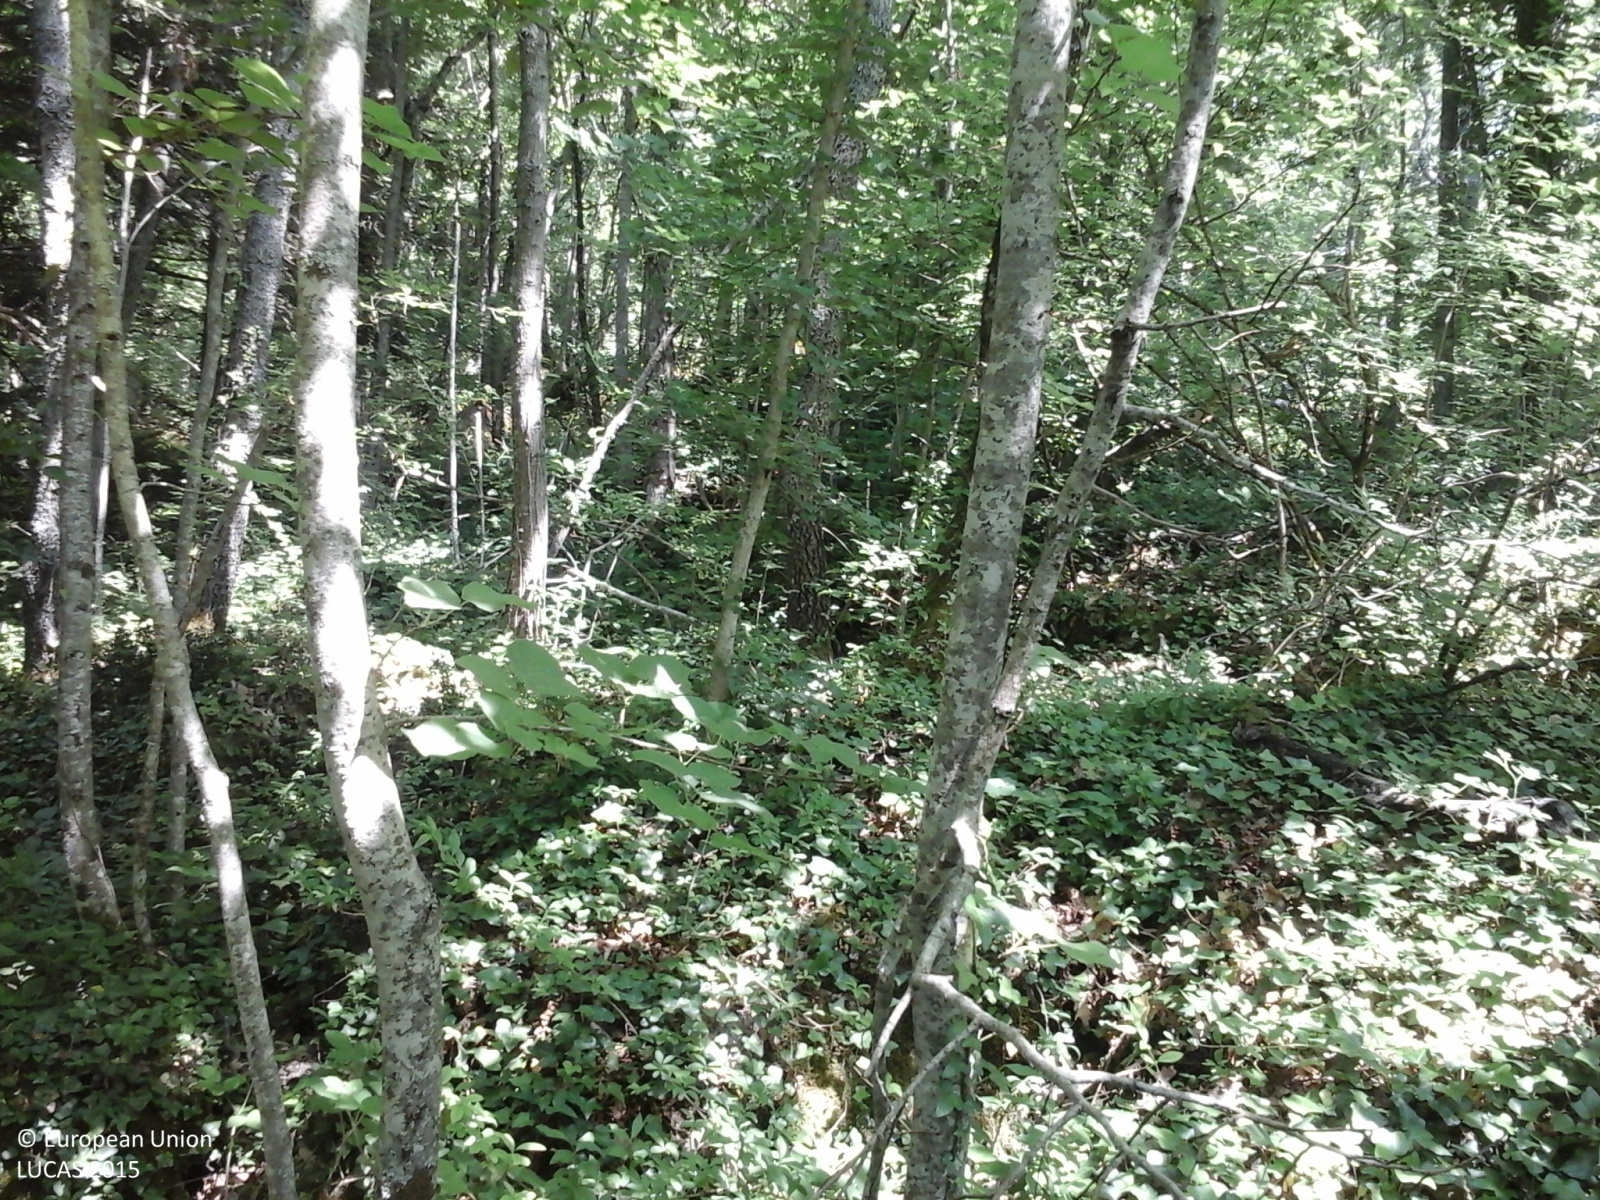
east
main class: Woodland
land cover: Other mixed woodland
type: hemiboreal forest and nemoral coniferous forest and mixed broadleaved-coniferous forest
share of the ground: > 75 %
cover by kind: coniferous forest trees 40 %, broadleaved forest trees 40 %, shrubs 10 %, herbaceous plants 5 %, lichens and mosses 5 %
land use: Forestry
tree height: > 5 m
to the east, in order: Other mixed woodland
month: June
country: IT
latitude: 41.8929
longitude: 14.3125
